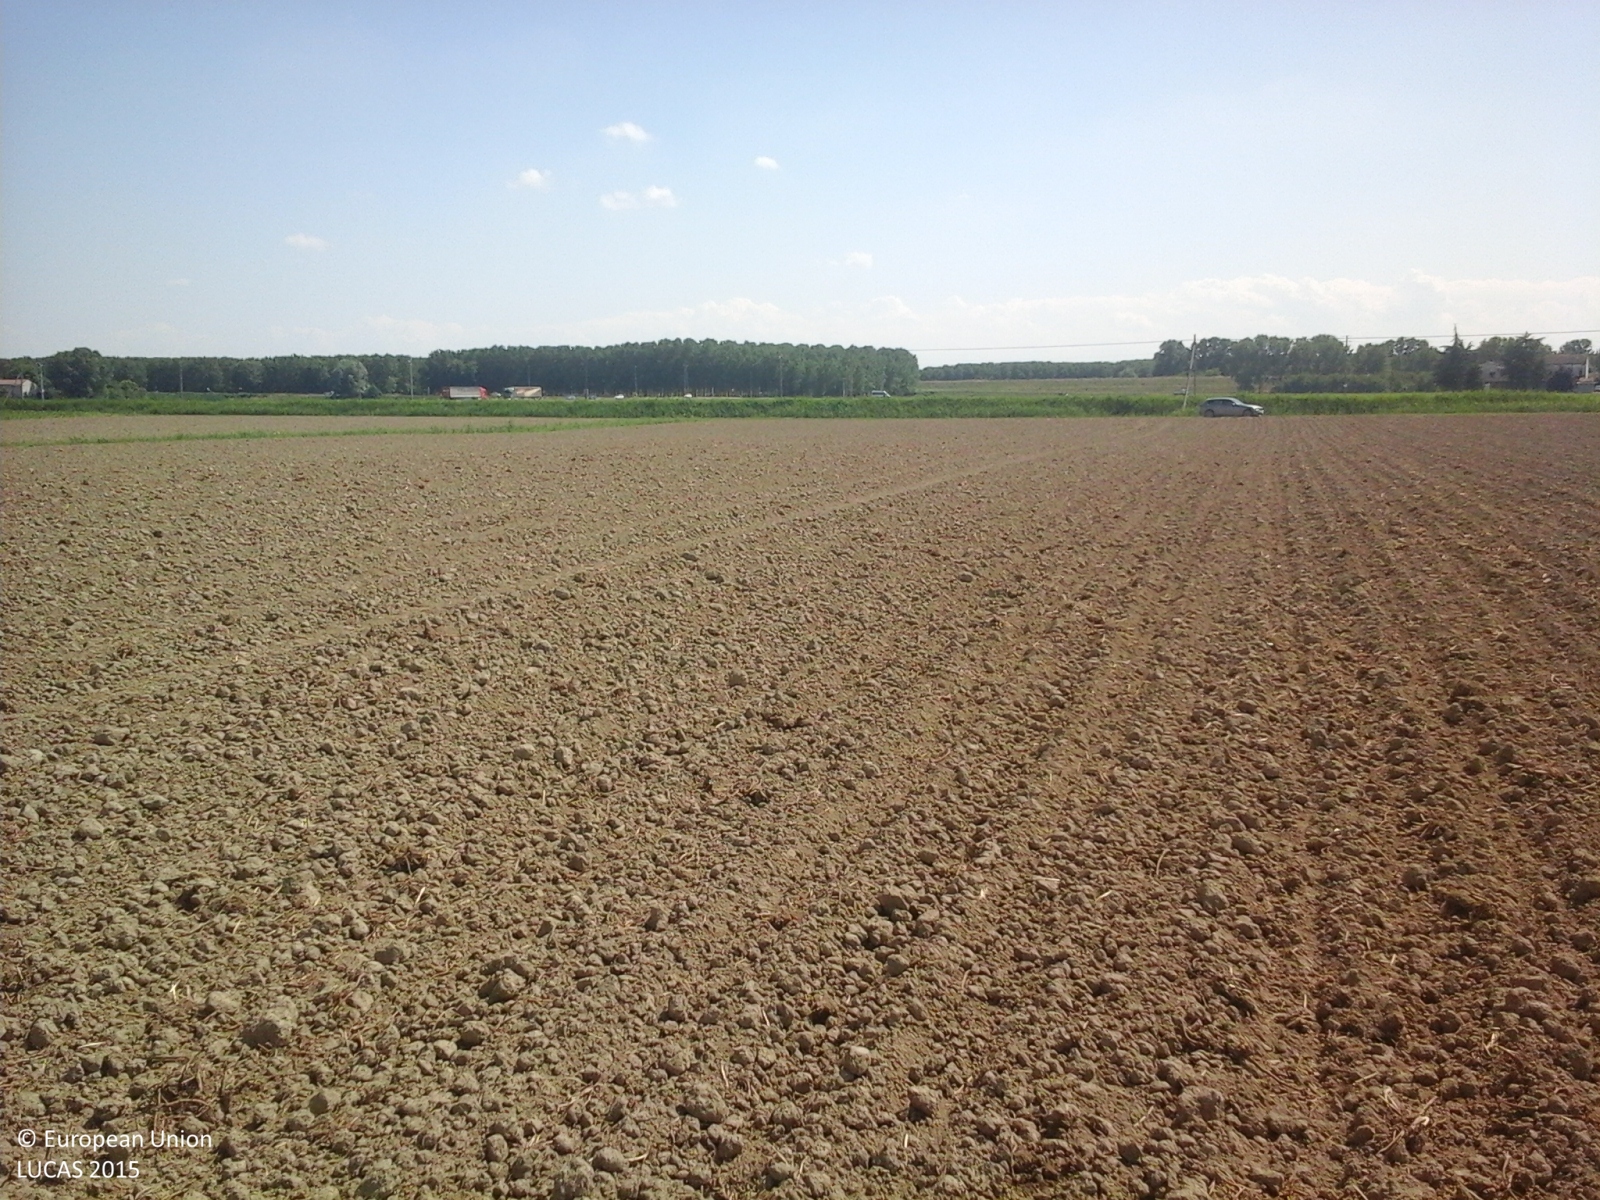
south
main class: Cropland
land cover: Maize
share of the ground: < 10 %
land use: Agriculture (excluding fallow land and kitchen gardens)
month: May
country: IT
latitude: 45.0858
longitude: 10.9257
